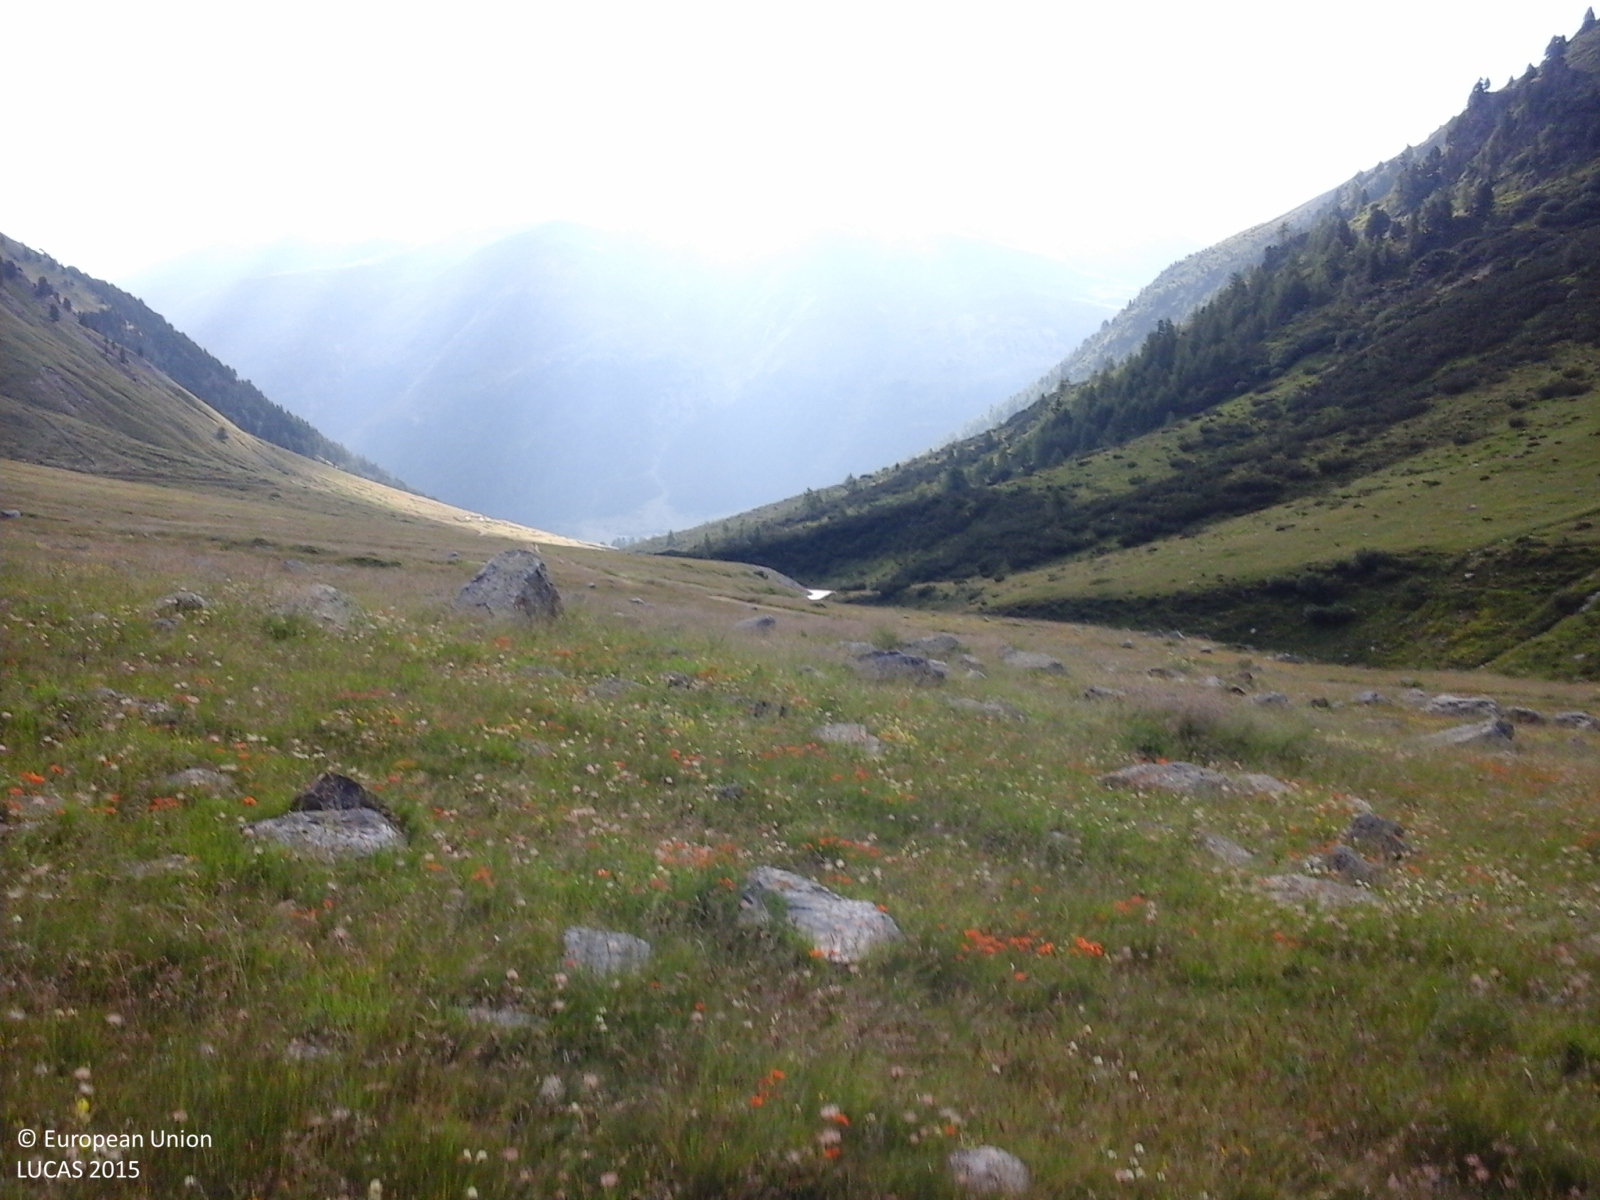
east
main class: Grassland
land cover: Grassland without tree/shrub cover
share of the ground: > 75 %
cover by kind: herbaceous plants 100 %
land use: Agriculture (excluding fallow land and kitchen gardens)
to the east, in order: Grassland without tree/shrub cover; Tracks; Grassland without tree/shrub cover; Rocks and stones; Inland fresh running water
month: July
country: IT
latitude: 46.4592
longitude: 10.0650
